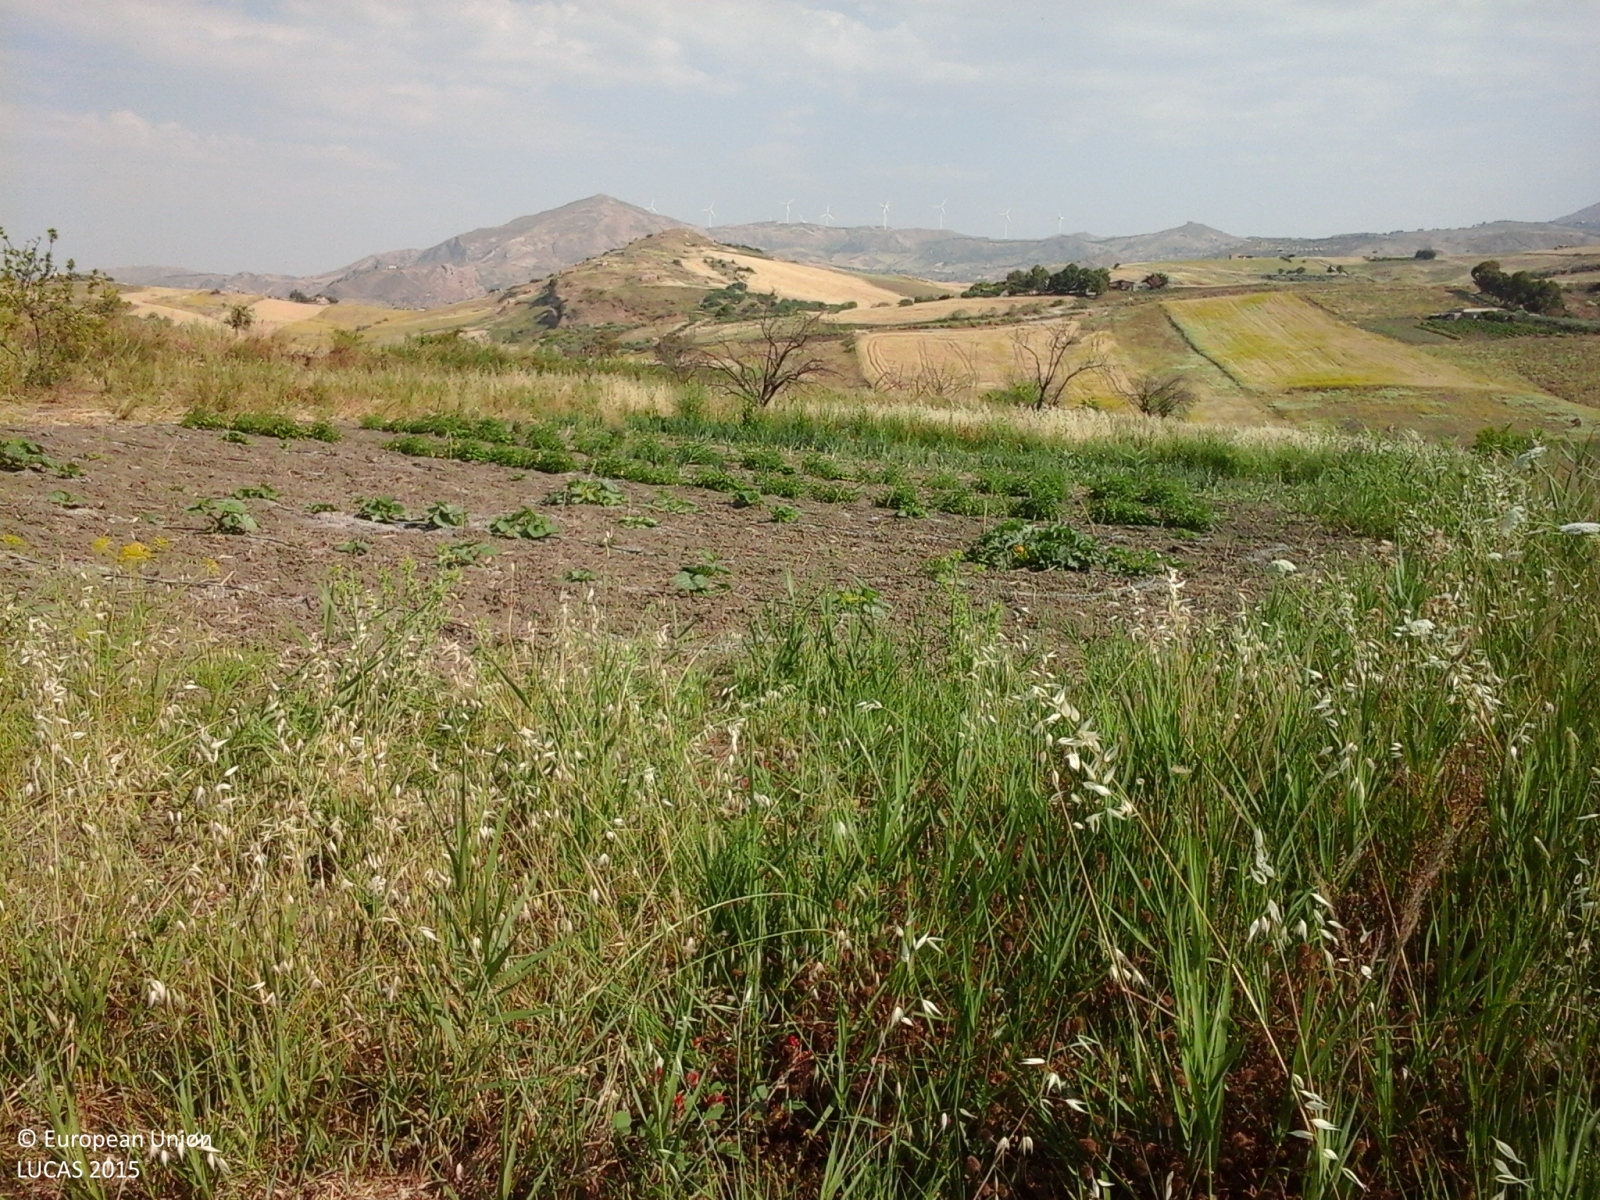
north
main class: Cropland
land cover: Olive groves
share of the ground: > 75 %
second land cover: Other bare soil
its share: > 75 %
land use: Agriculture (excluding fallow land and kitchen gardens)
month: June
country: IT
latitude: 37.3748
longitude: 13.4850
